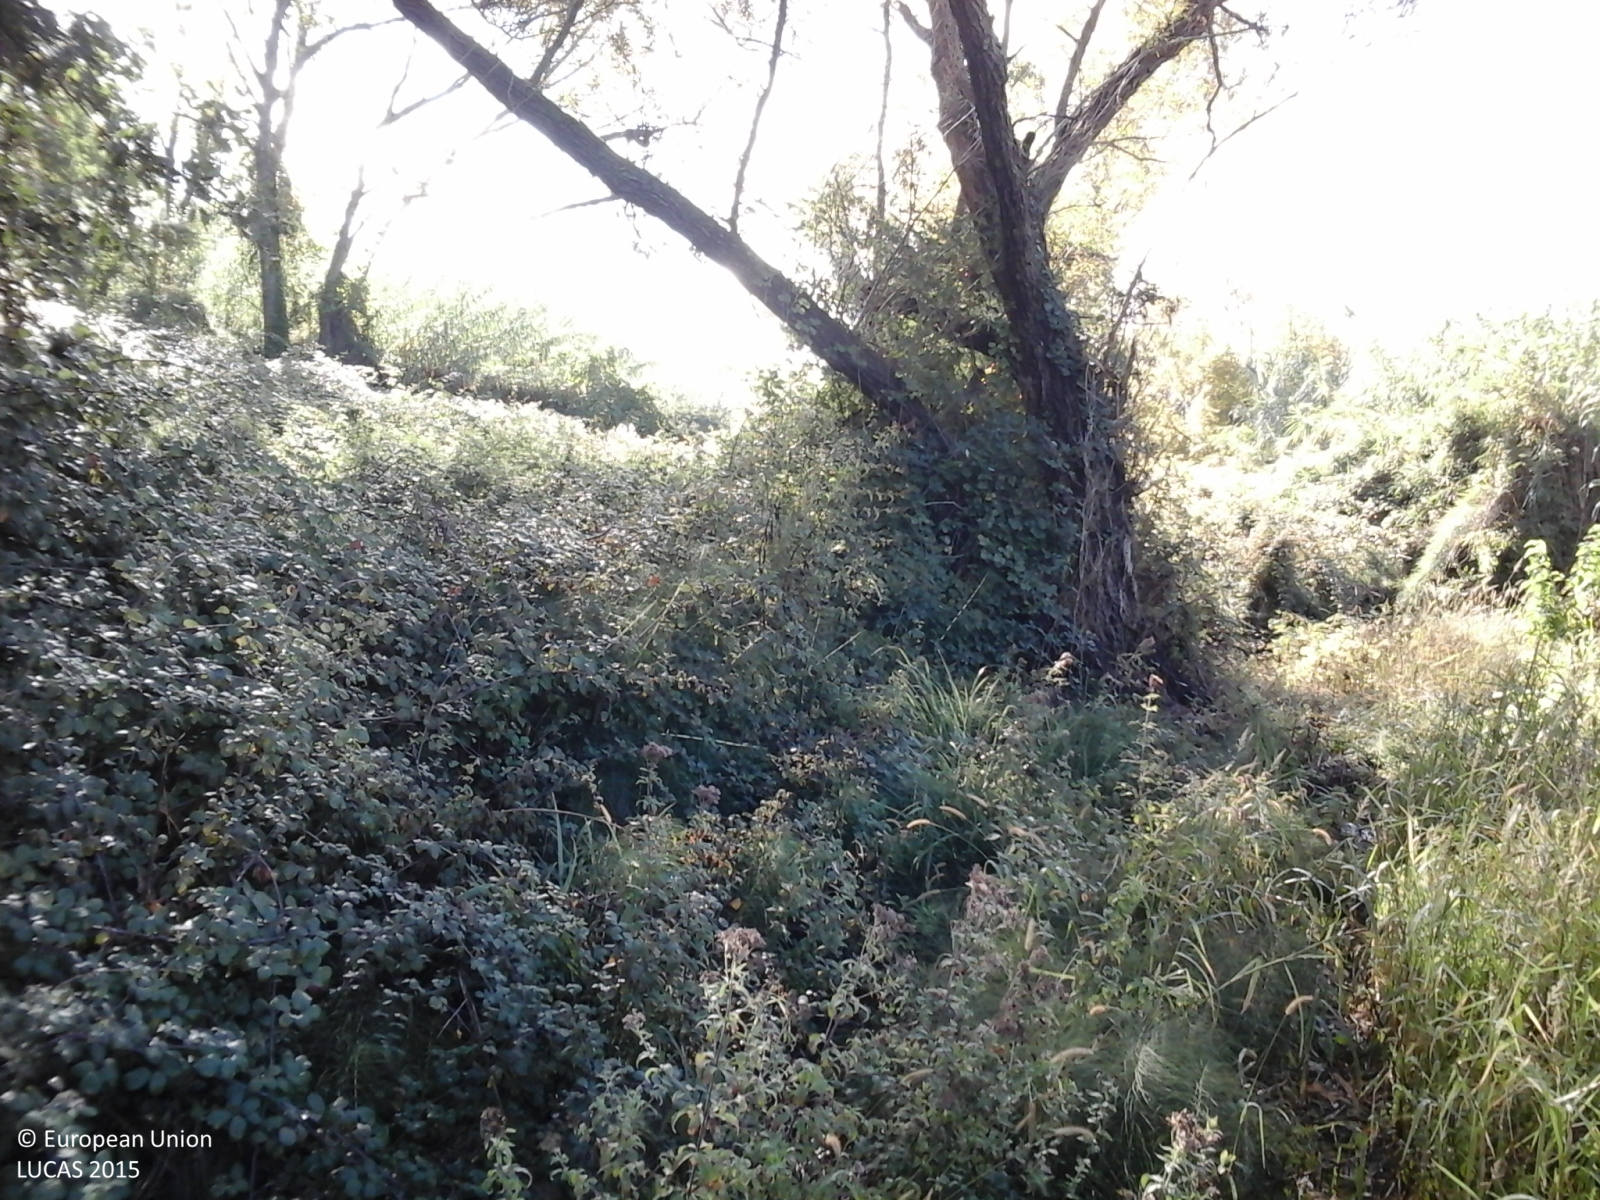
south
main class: Woodland
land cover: Broadleaved woodland
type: thermophilous deciduous forest
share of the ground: > 75 %
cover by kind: broadleaved forest trees 100 %
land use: Forestry
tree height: > 5 m
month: October
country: IT
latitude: 43.5727
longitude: 13.3970
